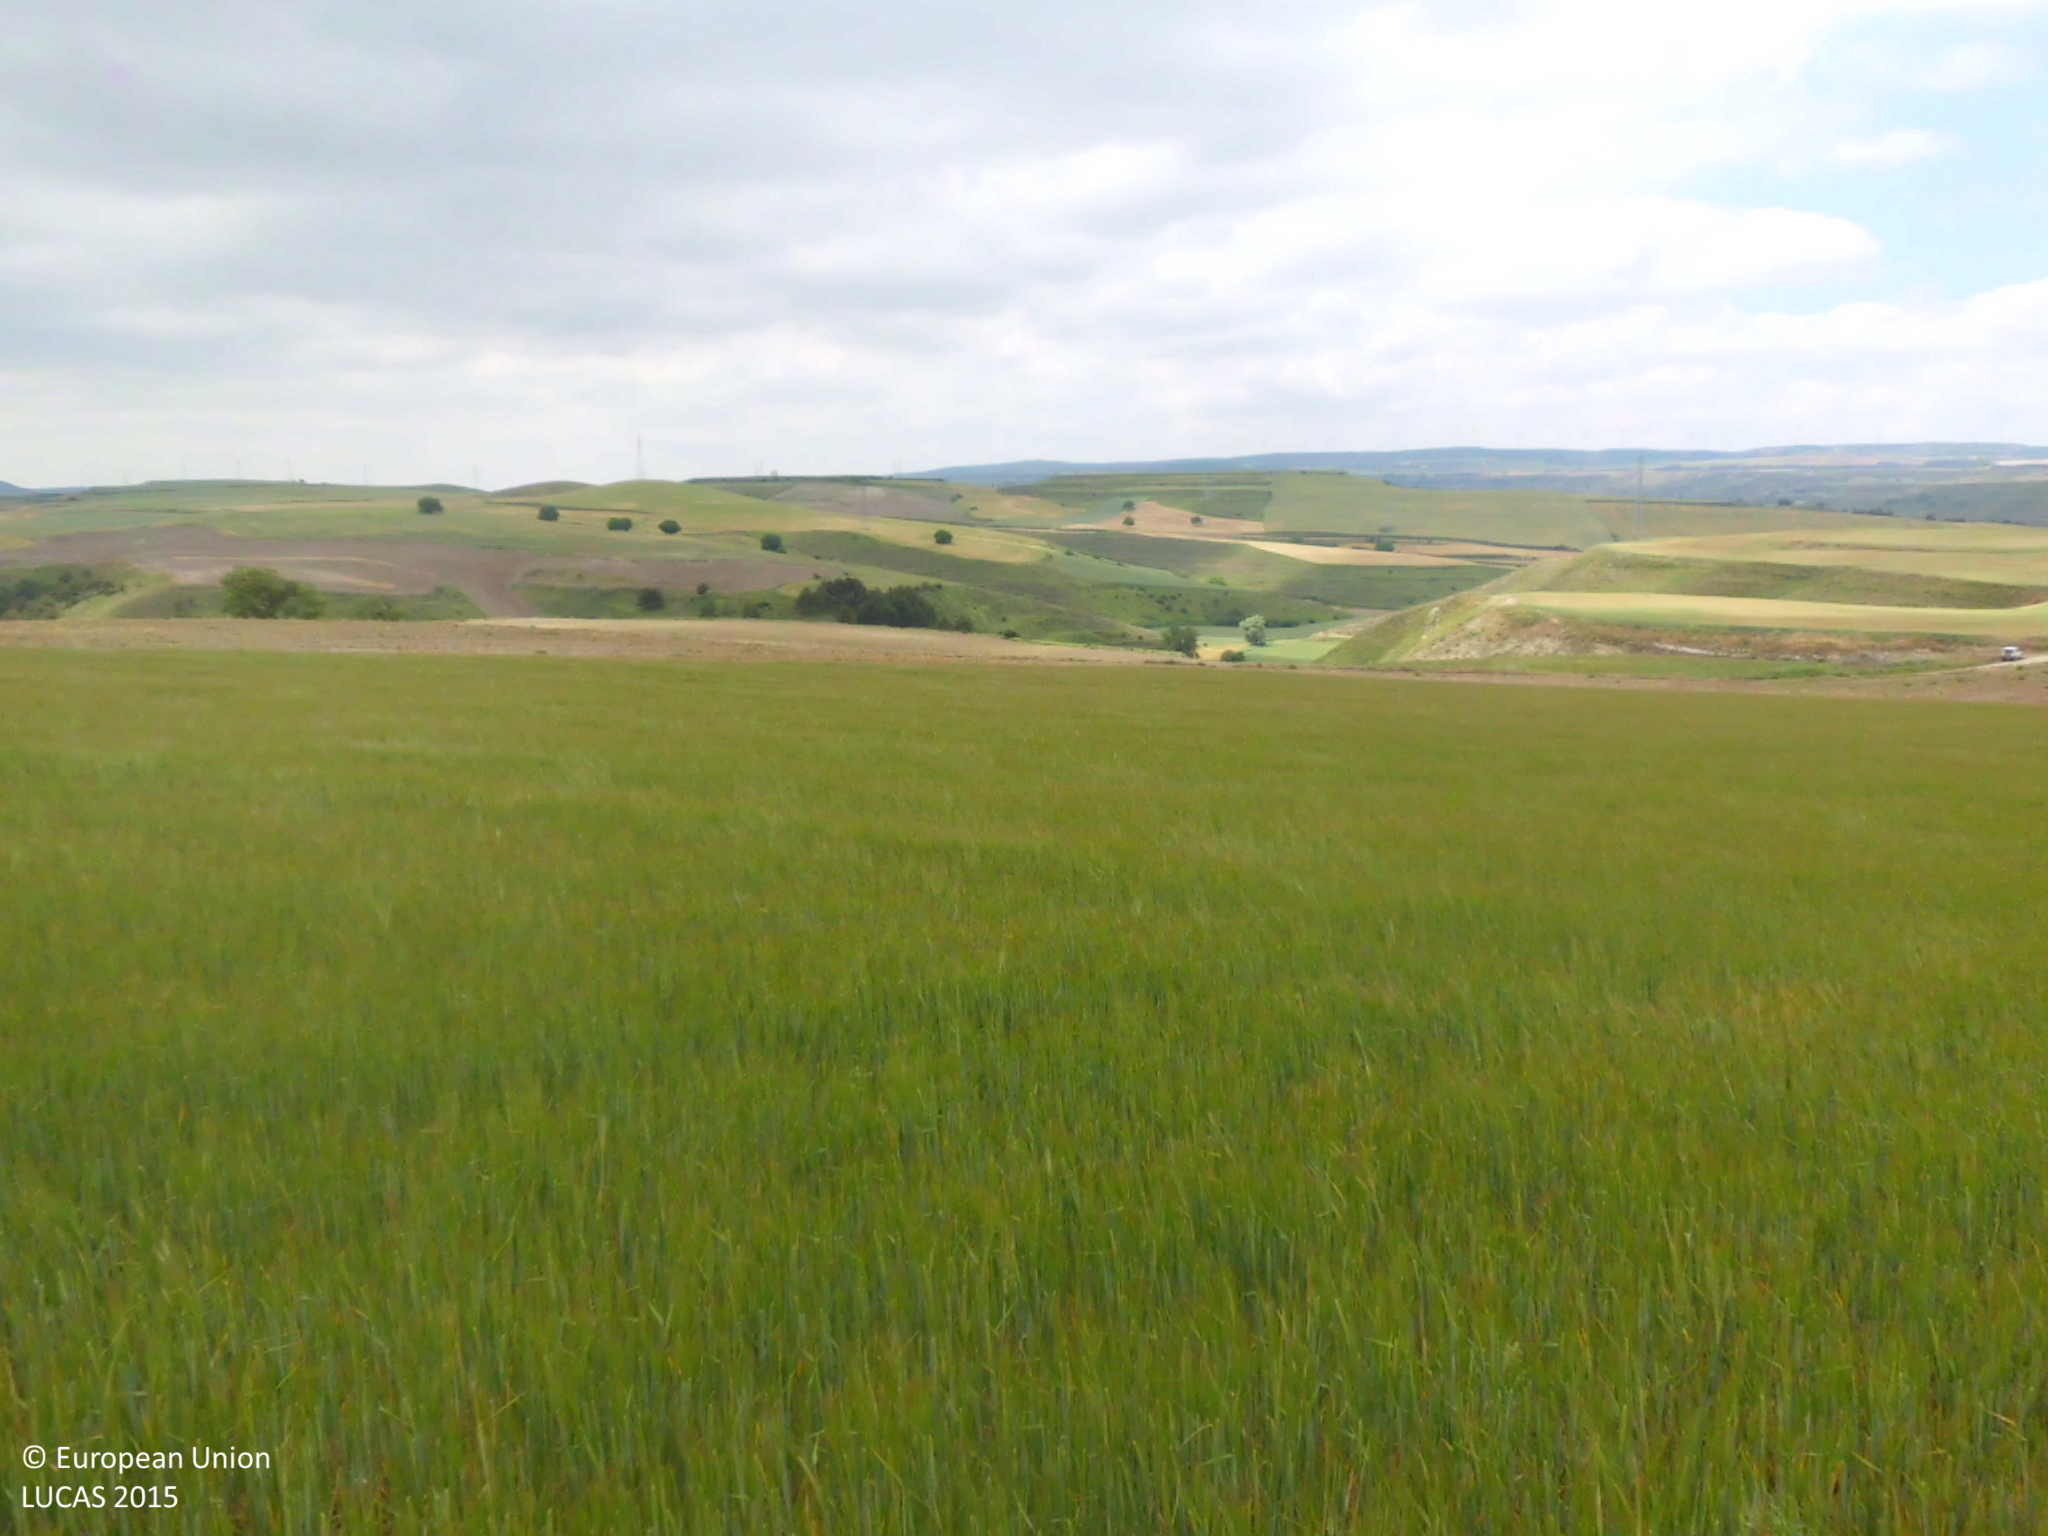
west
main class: Cropland
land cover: Barley
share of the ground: > 75 %
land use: Agriculture (excluding fallow land and kitchen gardens)
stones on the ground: < 10 %
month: June
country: ES
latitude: 42.5203
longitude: -3.3125
